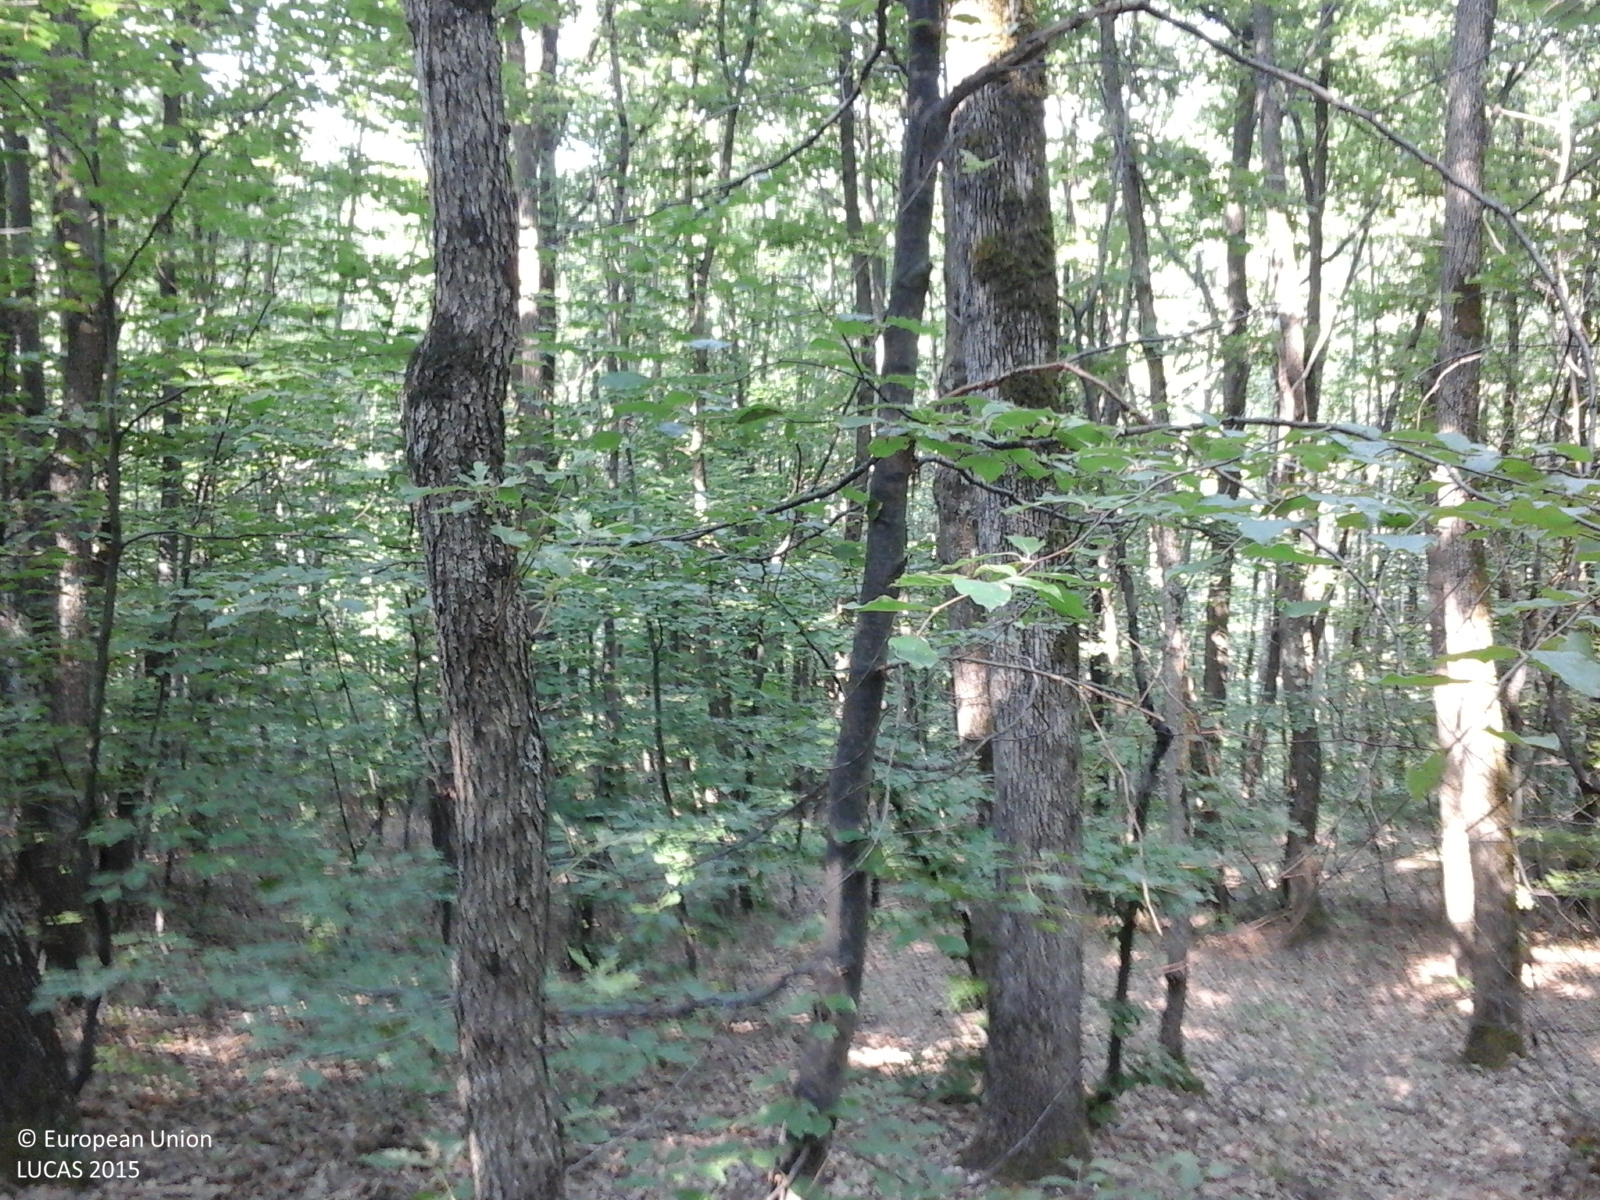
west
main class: Woodland
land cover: Broadleaved woodland
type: acidophilous oak and oak-birch forest
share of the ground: > 75 %
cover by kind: broadleaved forest trees 100 %
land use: Forestry
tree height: > 5 m
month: July
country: RO
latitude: 44.9668
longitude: 24.6715
